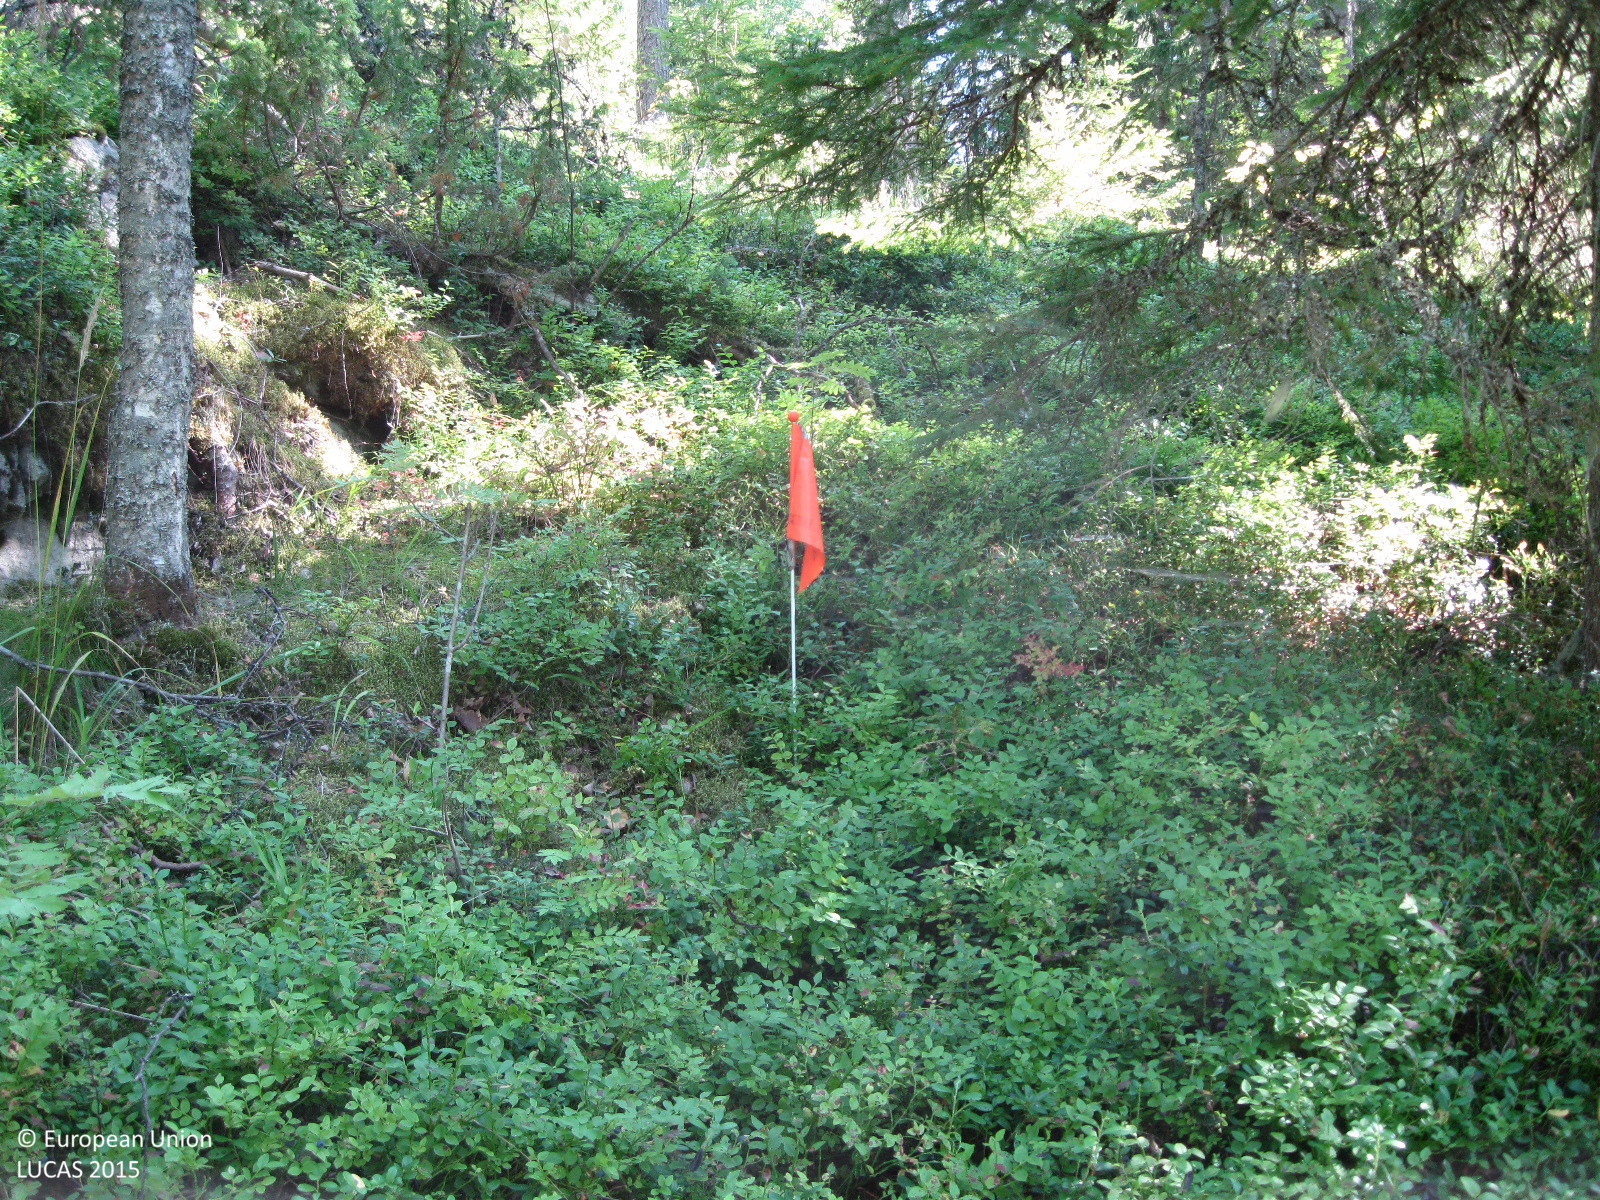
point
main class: Woodland
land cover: Other mixed woodland
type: boreal forest
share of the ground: 25 - 50 %
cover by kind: shrubs 50 %, coniferous forest trees 30 %, broadleaved forest trees 10 %, herbaceous plants 10 %
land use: Forestry
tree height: > 5 m
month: August
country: FI
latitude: 61.3347
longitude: 25.0432
